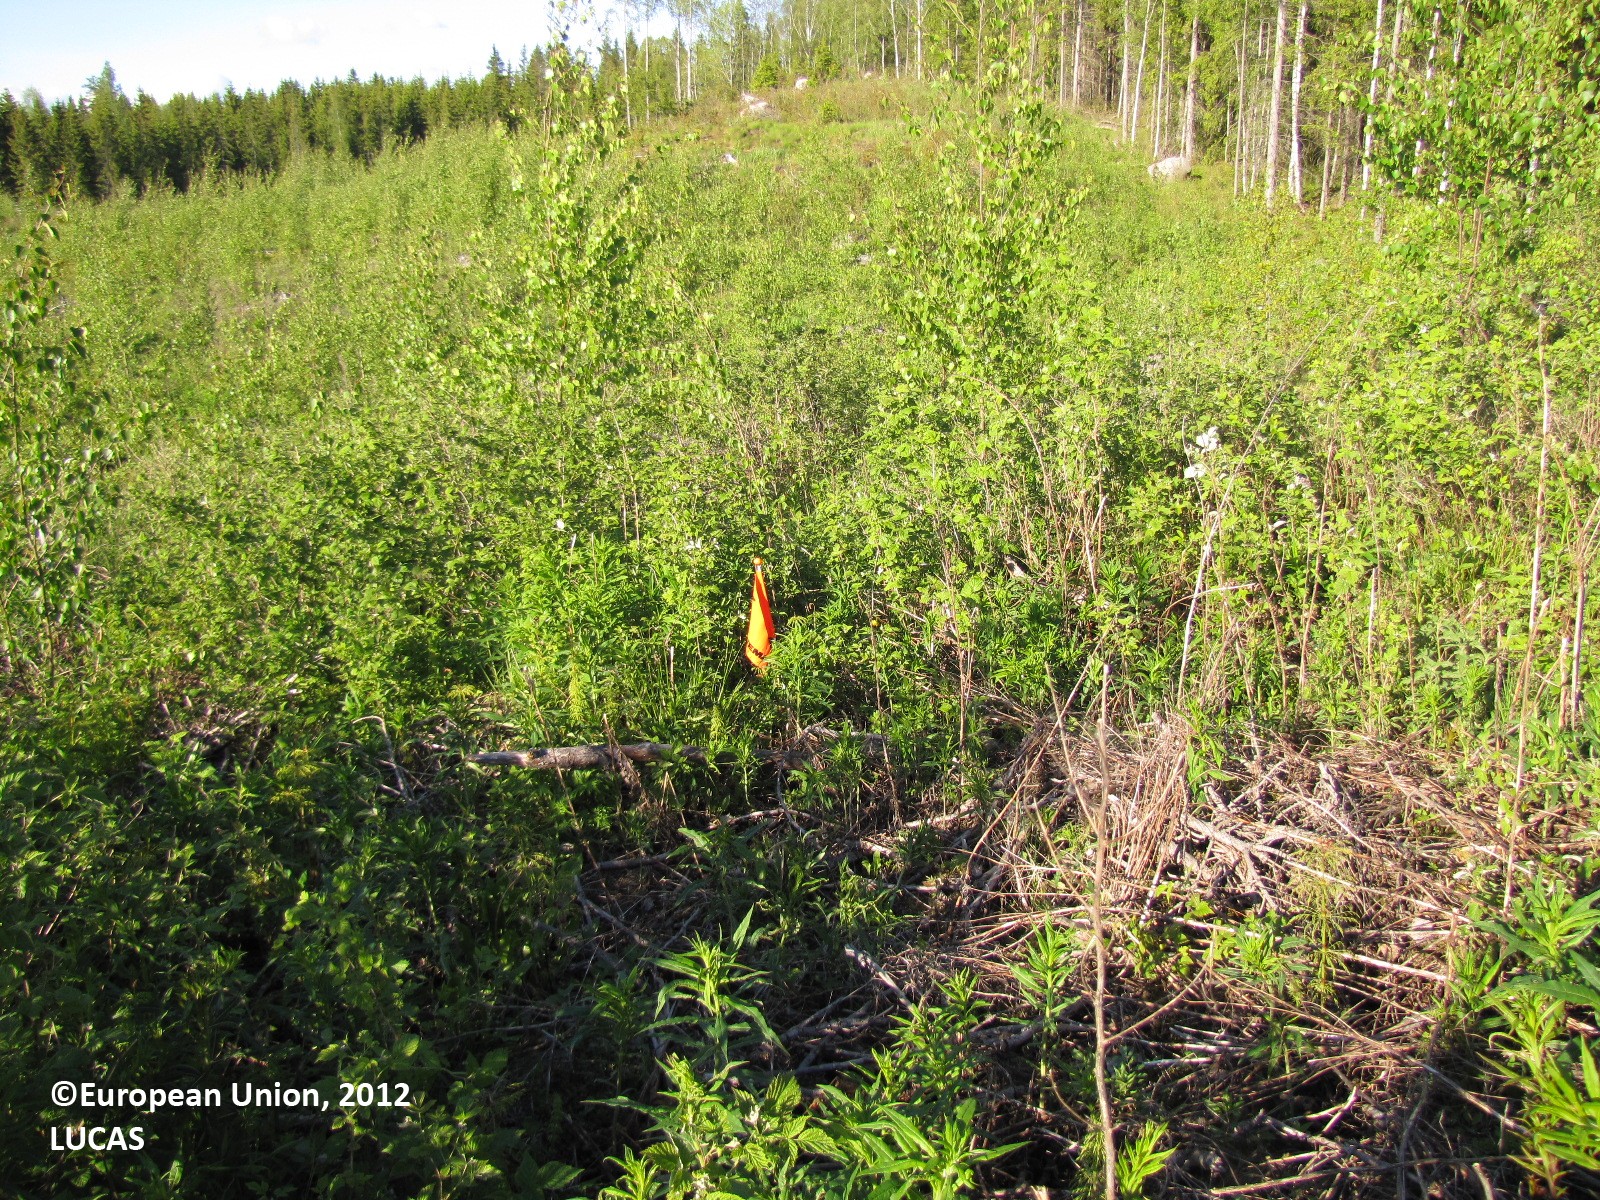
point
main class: Woodland
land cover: Broadleaved woodland
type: boreal forest
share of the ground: 25 - 50 %
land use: Forestry
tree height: < 5 m
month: June
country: FI
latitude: 61.3926
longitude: 22.9330
